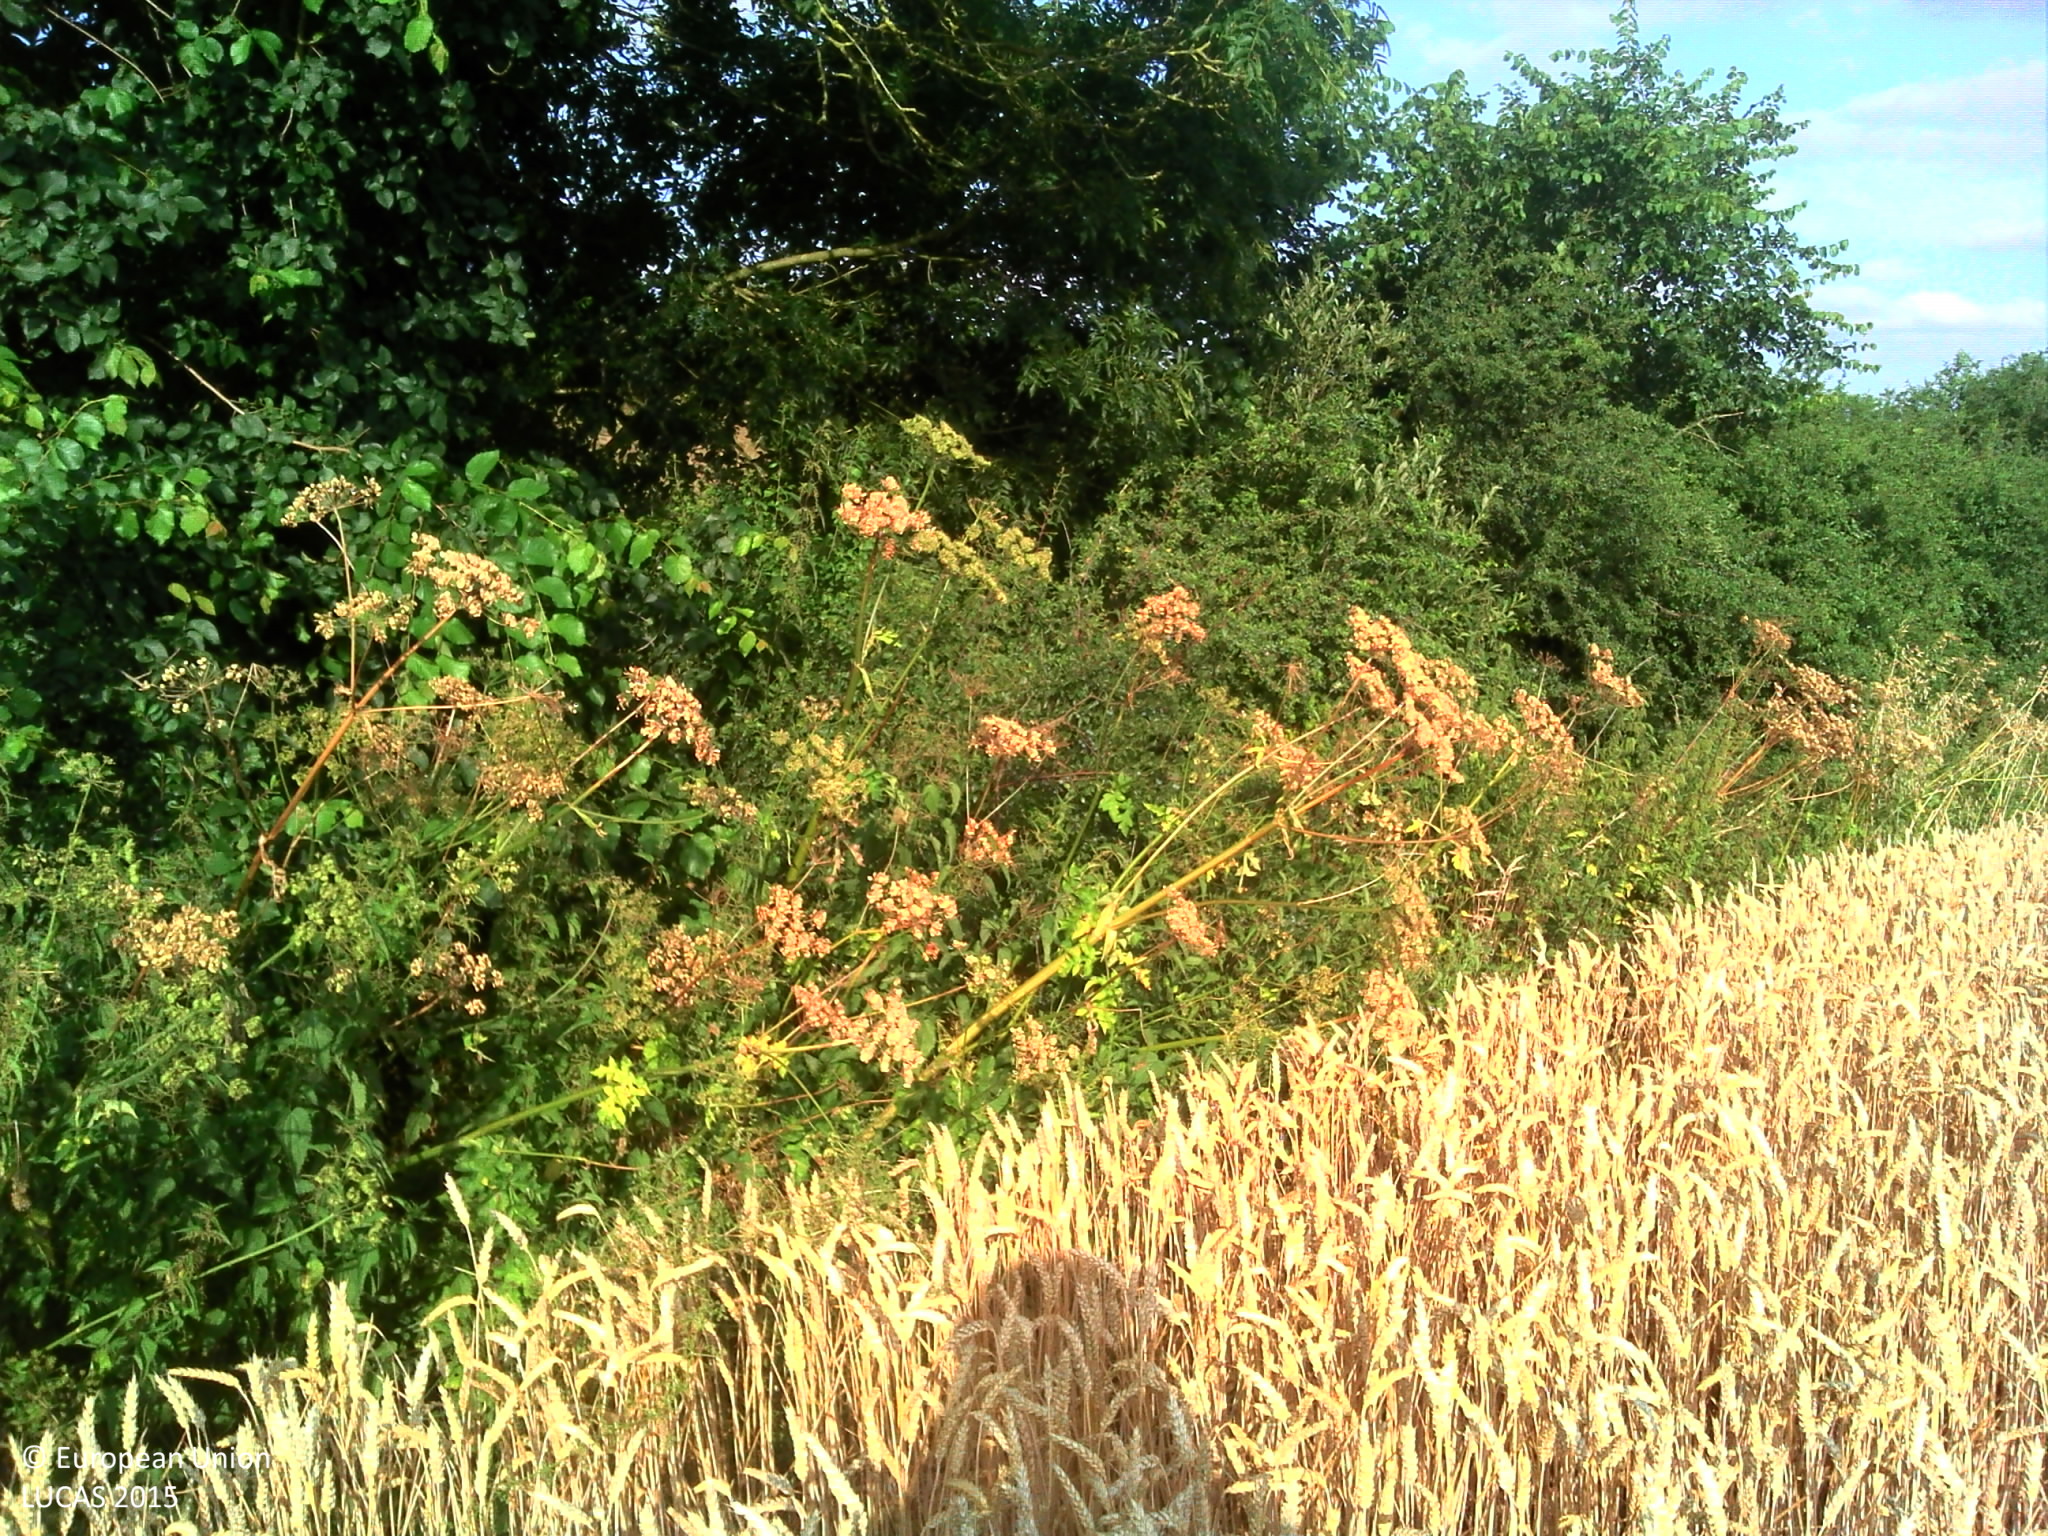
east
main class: Cropland
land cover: Common wheat
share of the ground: > 75 %
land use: Agriculture (excluding fallow land and kitchen gardens)
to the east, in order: Common wheat; Broadleaved woodland; Fences; Grassland without tree/shrub cover; Fences; Dry stone walls; Lines of trees; Grassland without tree/shrub cover; Fences; Managed hedges; Fences; Grassland without tree/shrub cover; Fences; Managed hedges; Ditches and canals; Grass margins; Paved roads, cycling and walking lanes; Grass margins; Fences; Other bare soil; Fences; Spontaneously vegetated surfaces
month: July
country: FR
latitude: 46.9319
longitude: -0.9482
